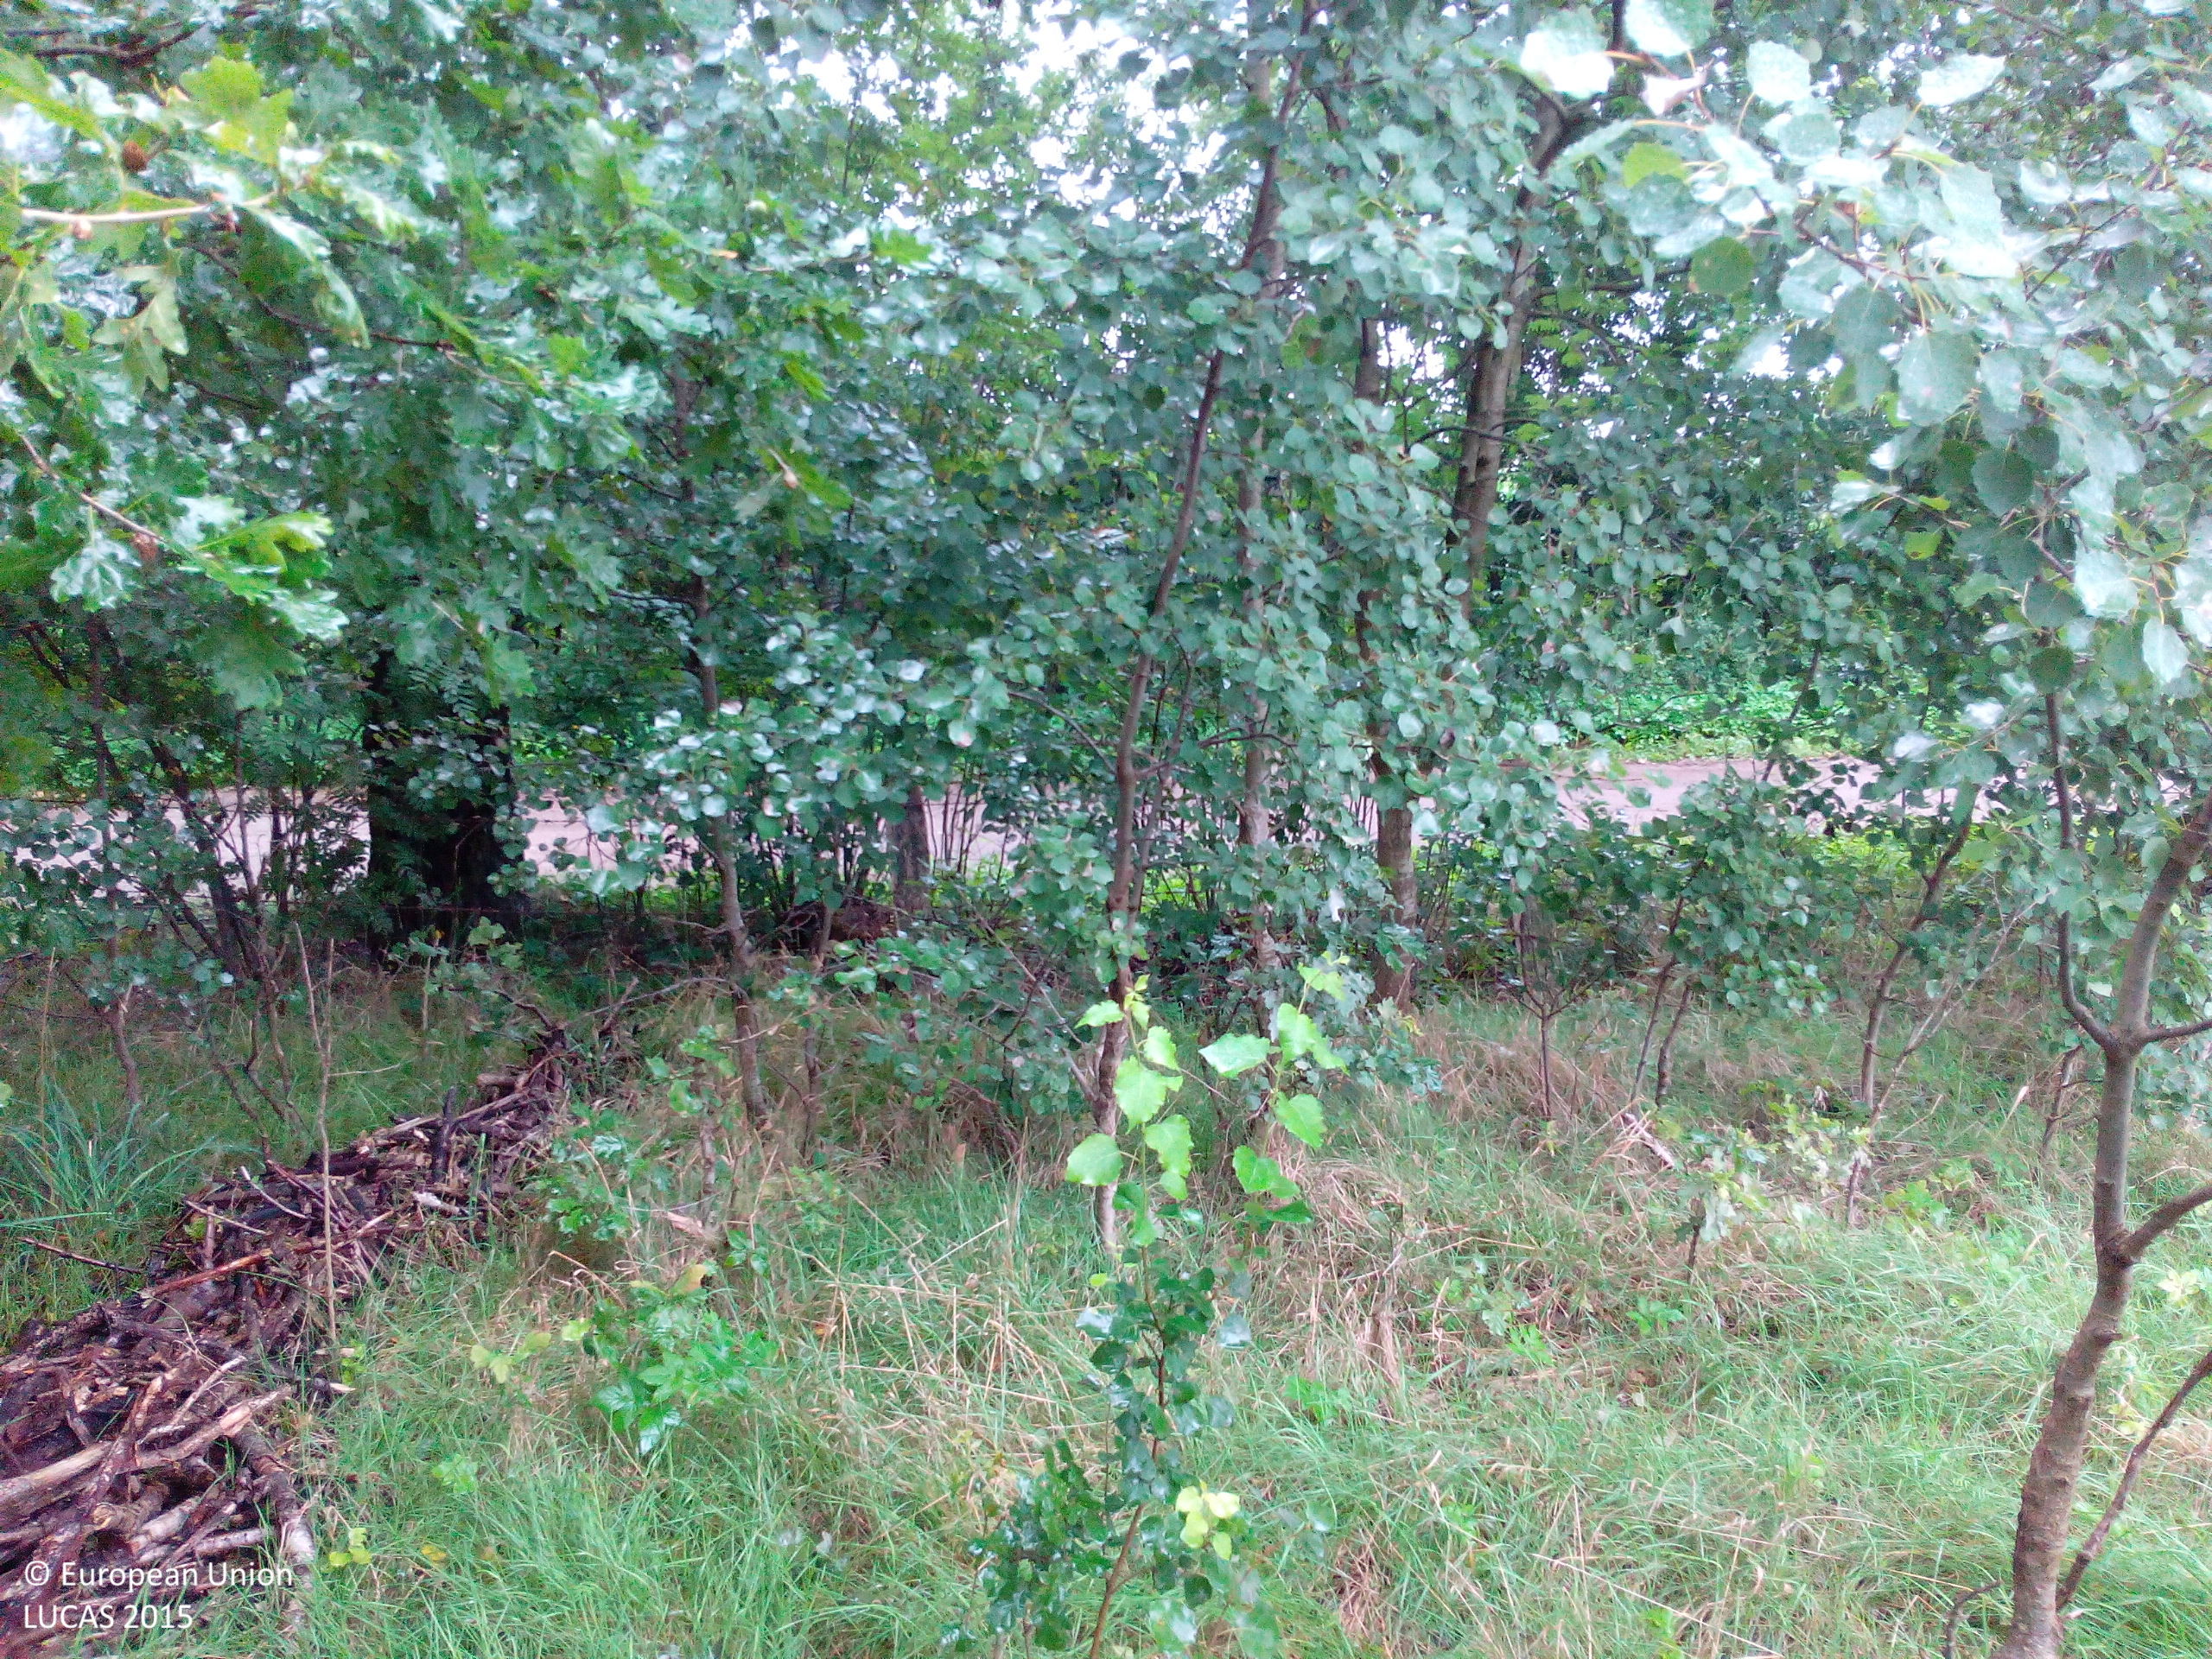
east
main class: Woodland
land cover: Broadleaved woodland
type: acidophilous oak and oak-birch forest
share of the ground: > 75 %
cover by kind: broadleaved forest trees 80 %, coniferous forest trees 10 %, herbaceous plants 10 %
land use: Agriculture (excluding fallow land and kitchen gardens)
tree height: > 5 m
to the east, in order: Broadleaved woodland; Fences; Broadleaved woodland; Tracks; Broadleaved woodland; Maize; Tracks; Broadleaved woodland; Grassland without tree/shrub cover; Fences; Grassland without tree/shrub cover
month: August
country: DE
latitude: 53.7434
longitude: 9.9242
